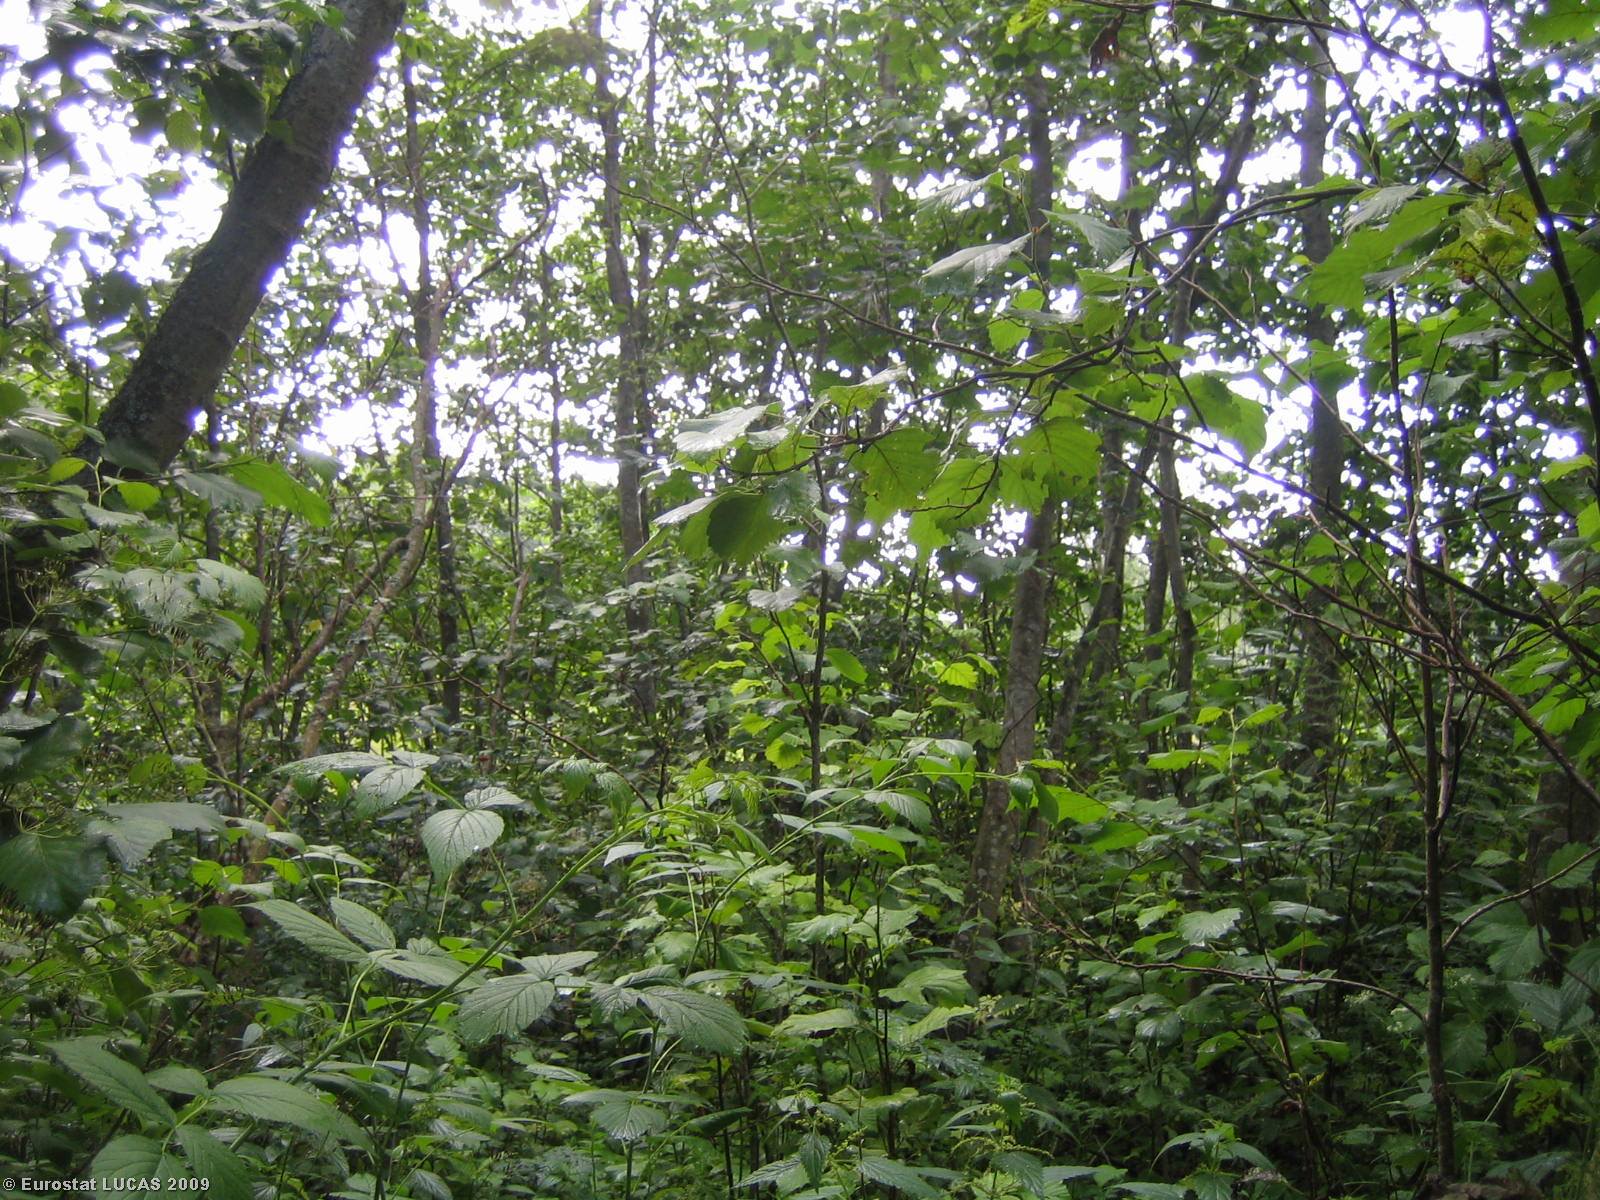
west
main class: Woodland
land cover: Mixed woodland
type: hemiboreal forest and nemoral coniferous forest and mixed broadleaved-coniferous forest
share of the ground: > 75 %
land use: Forestry
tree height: > 5 m
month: July
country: LT
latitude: 55.4619
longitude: 25.9033
